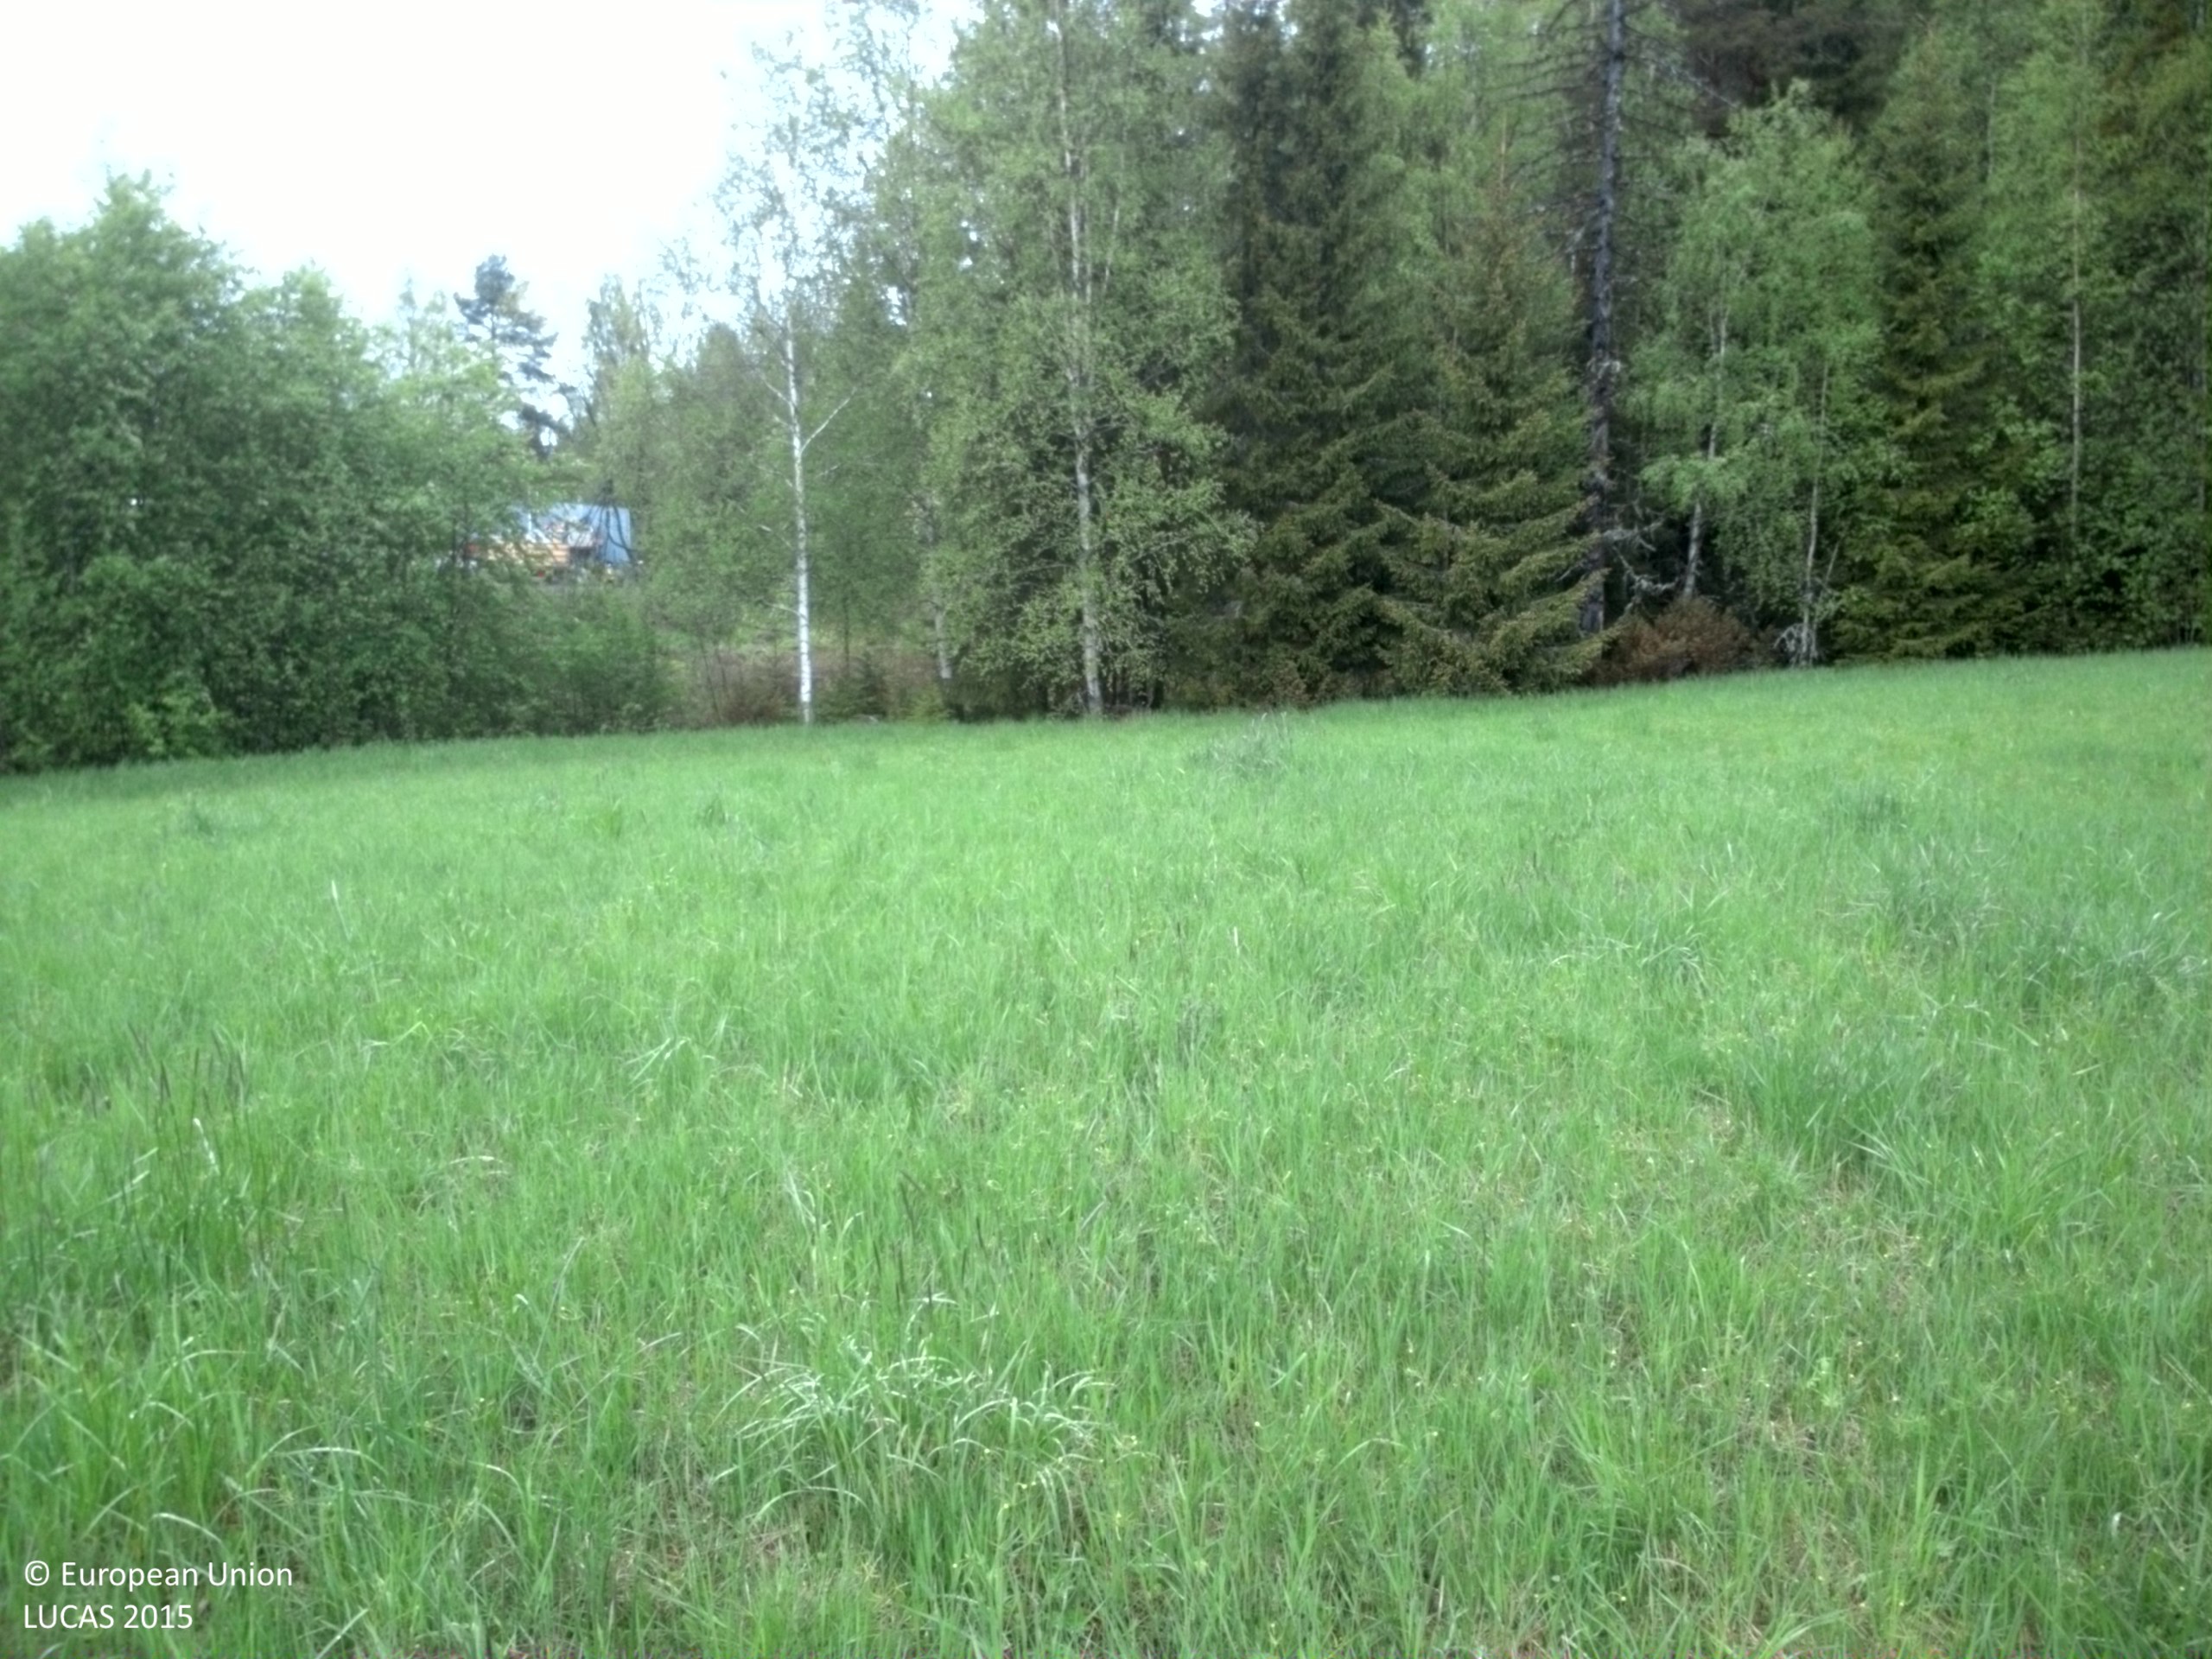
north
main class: Cropland
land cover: Temporary grasslands
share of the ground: > 75 %
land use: Agriculture (excluding fallow land and kitchen gardens)
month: June
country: SE
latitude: 63.2106
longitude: 16.9955
